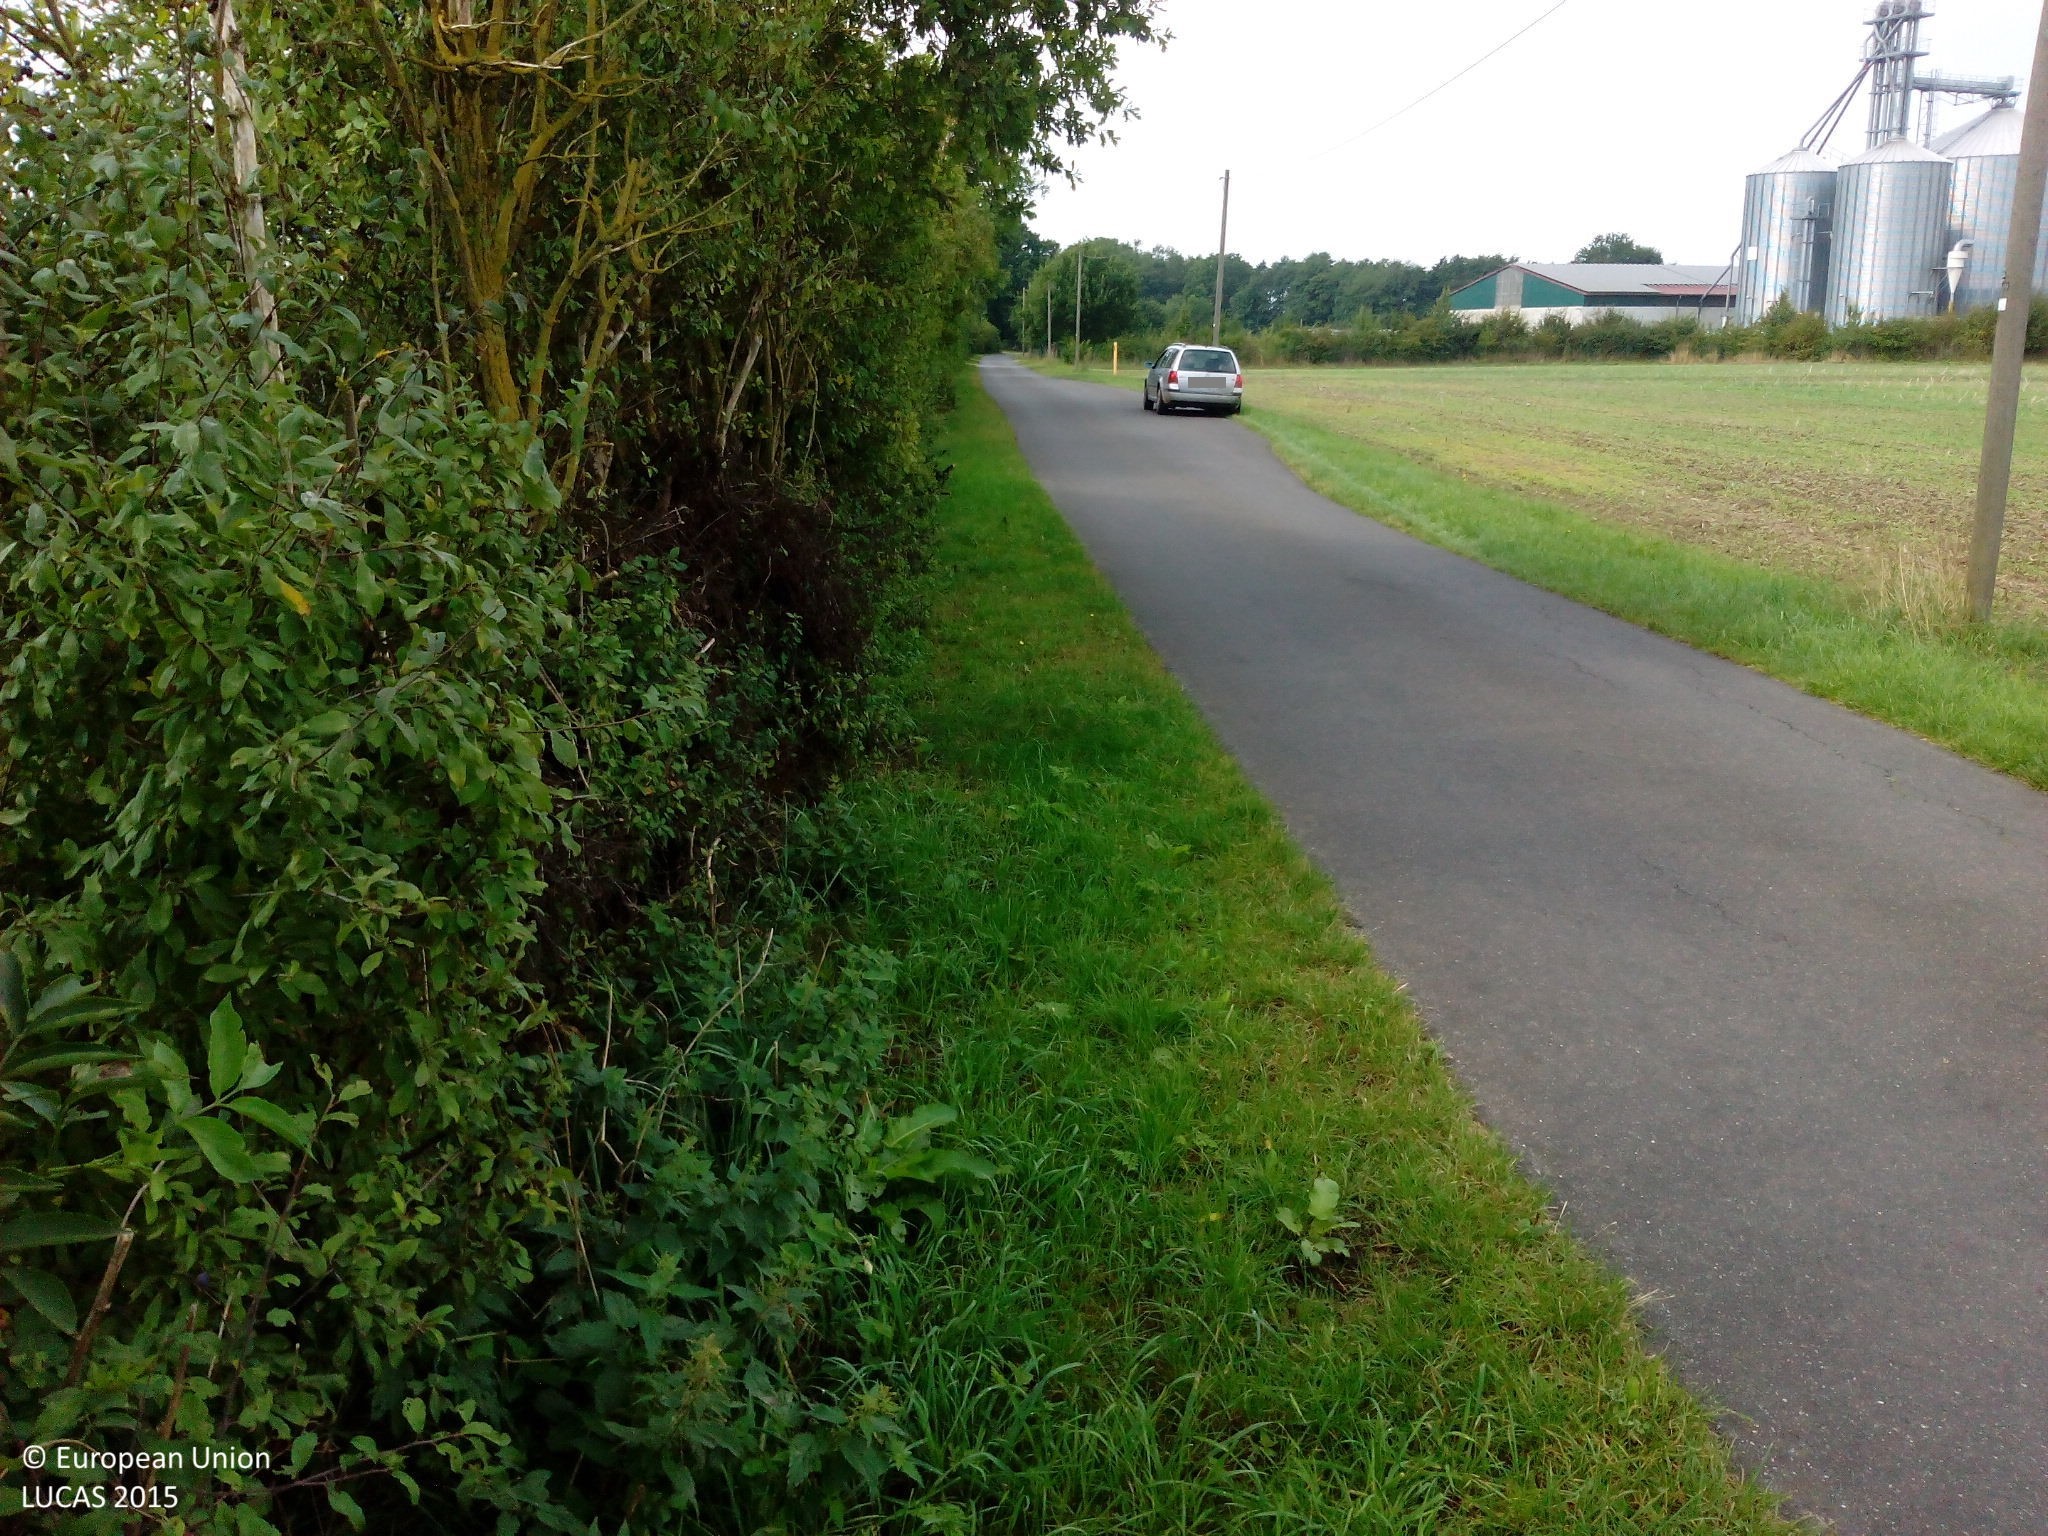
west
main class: Cropland
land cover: Rape and turnip rape
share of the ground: 10 - 25 %
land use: Agriculture (excluding fallow land and kitchen gardens)
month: August
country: DE
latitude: 54.2008
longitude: 12.6204
